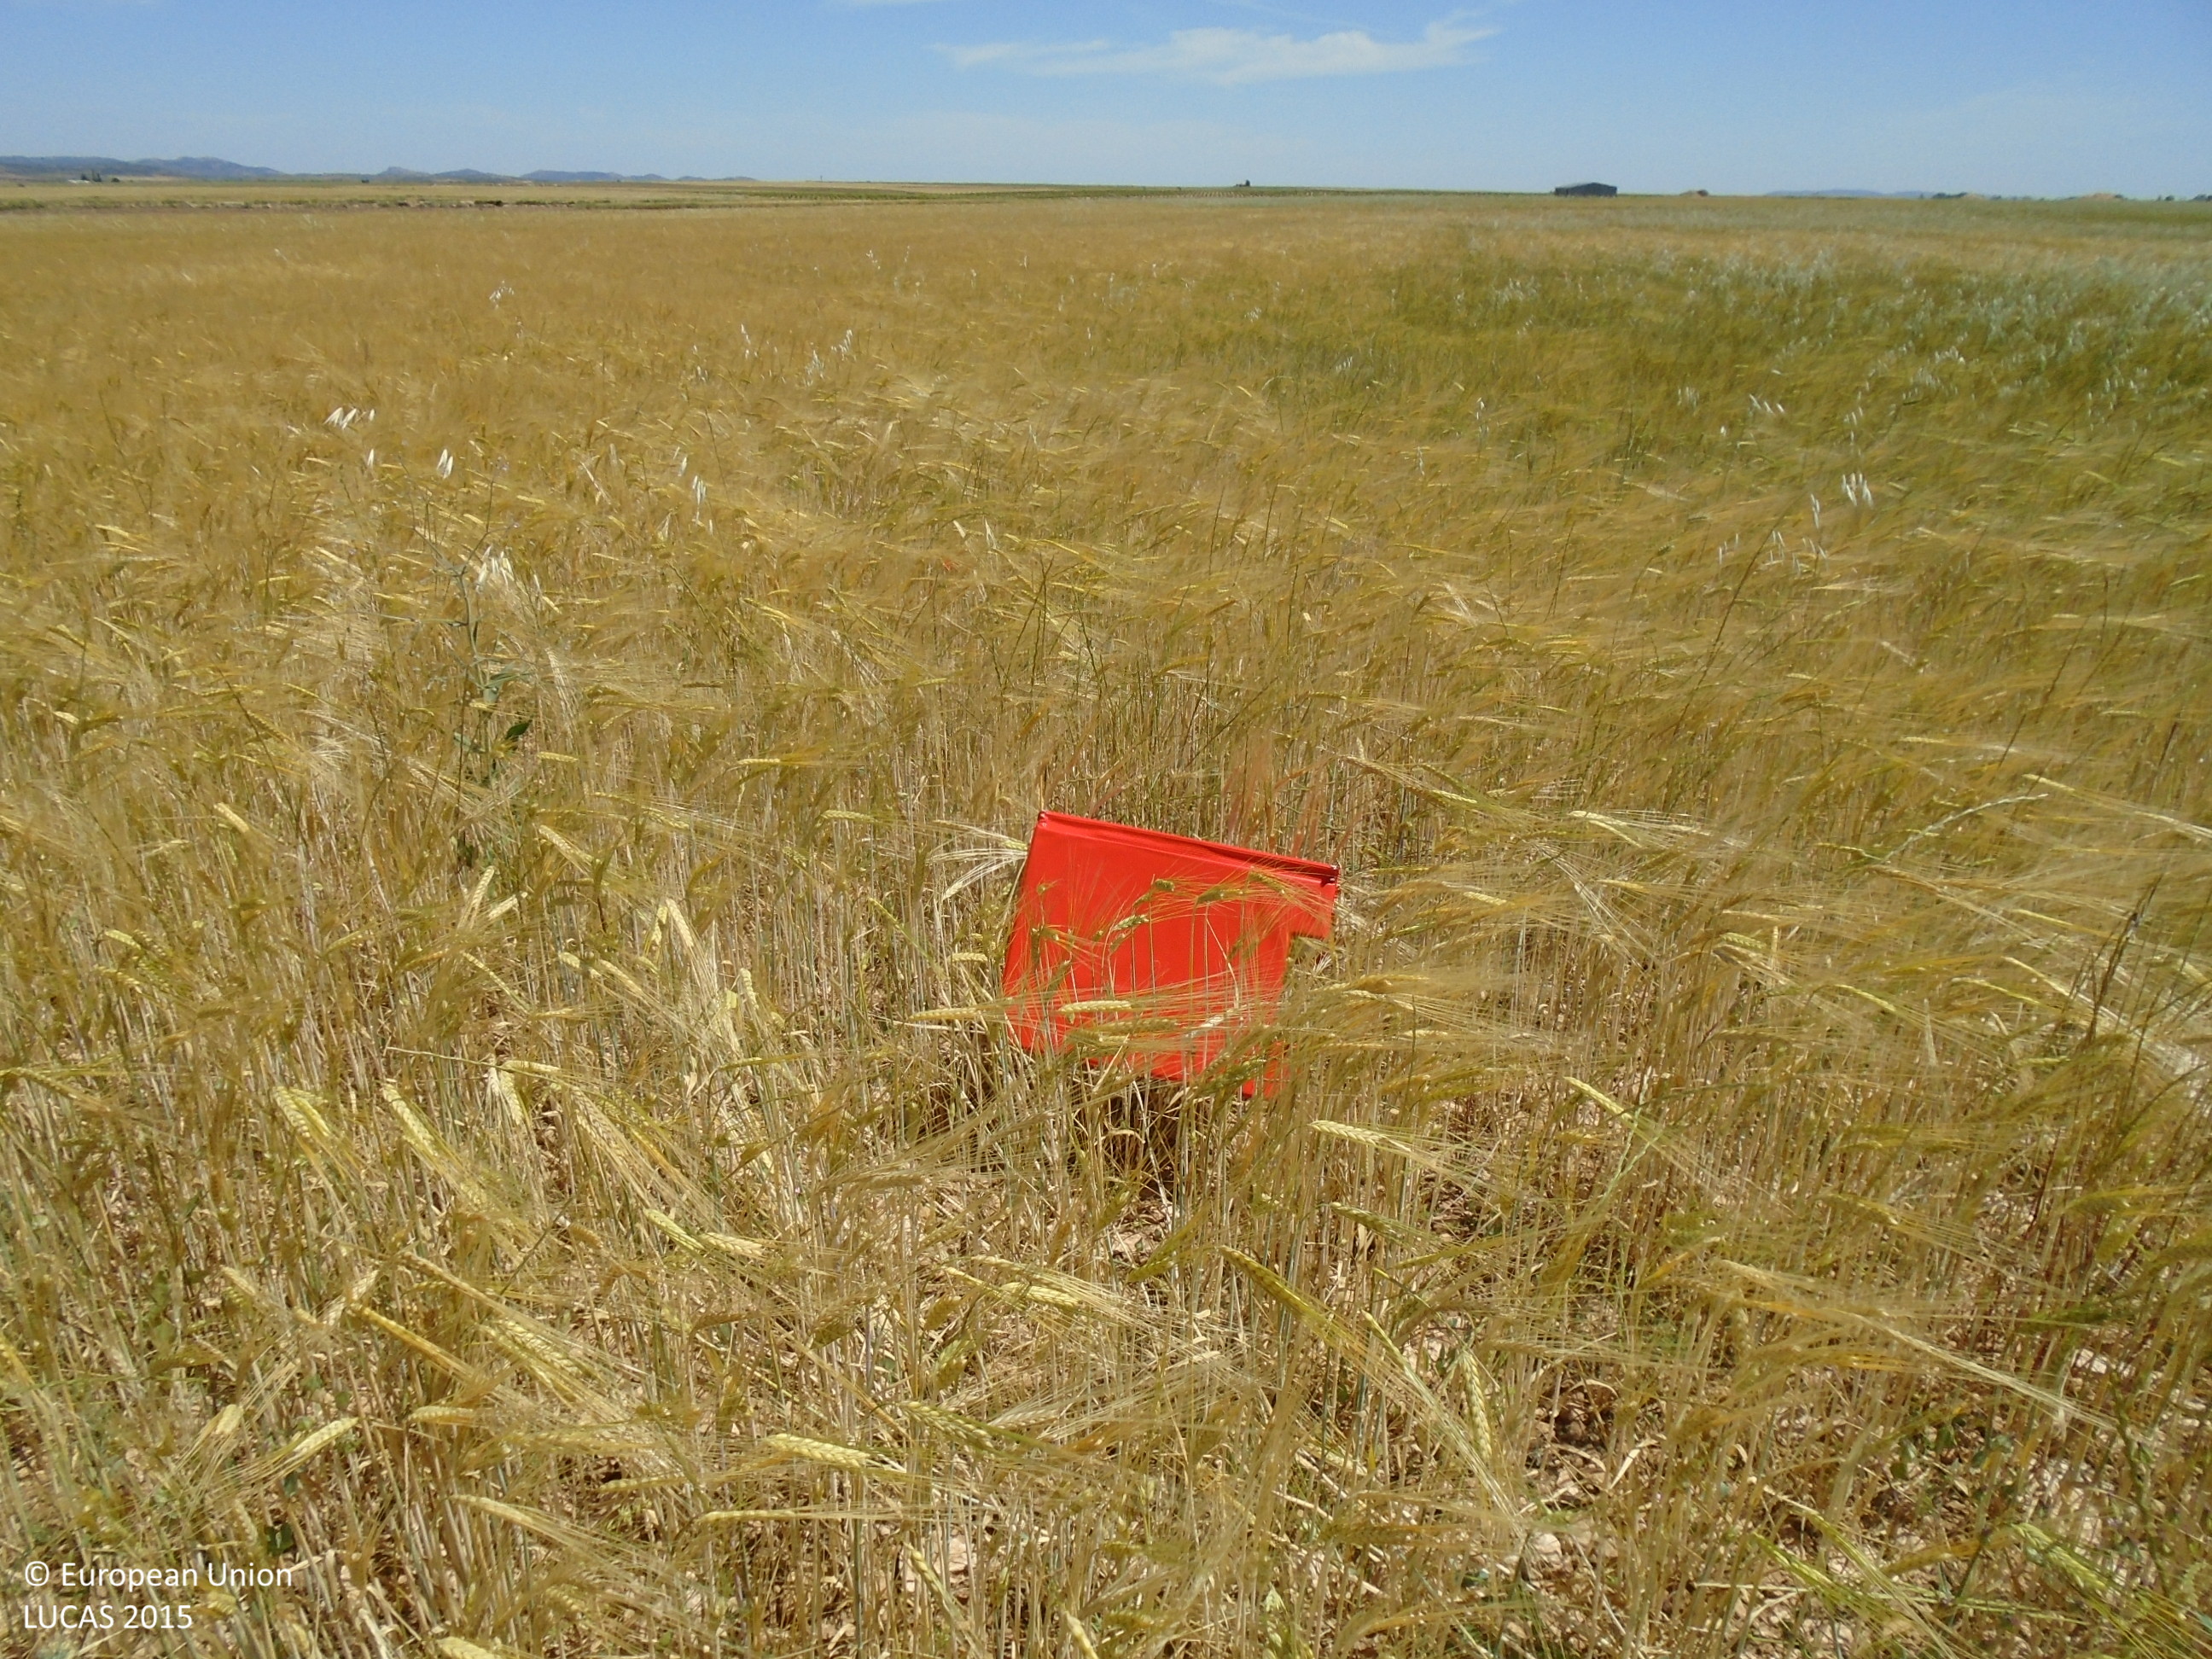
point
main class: Cropland
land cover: Barley
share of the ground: > 75 %
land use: Agriculture (excluding fallow land and kitchen gardens)
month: May
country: ES
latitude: 39.4978
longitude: -3.7356
